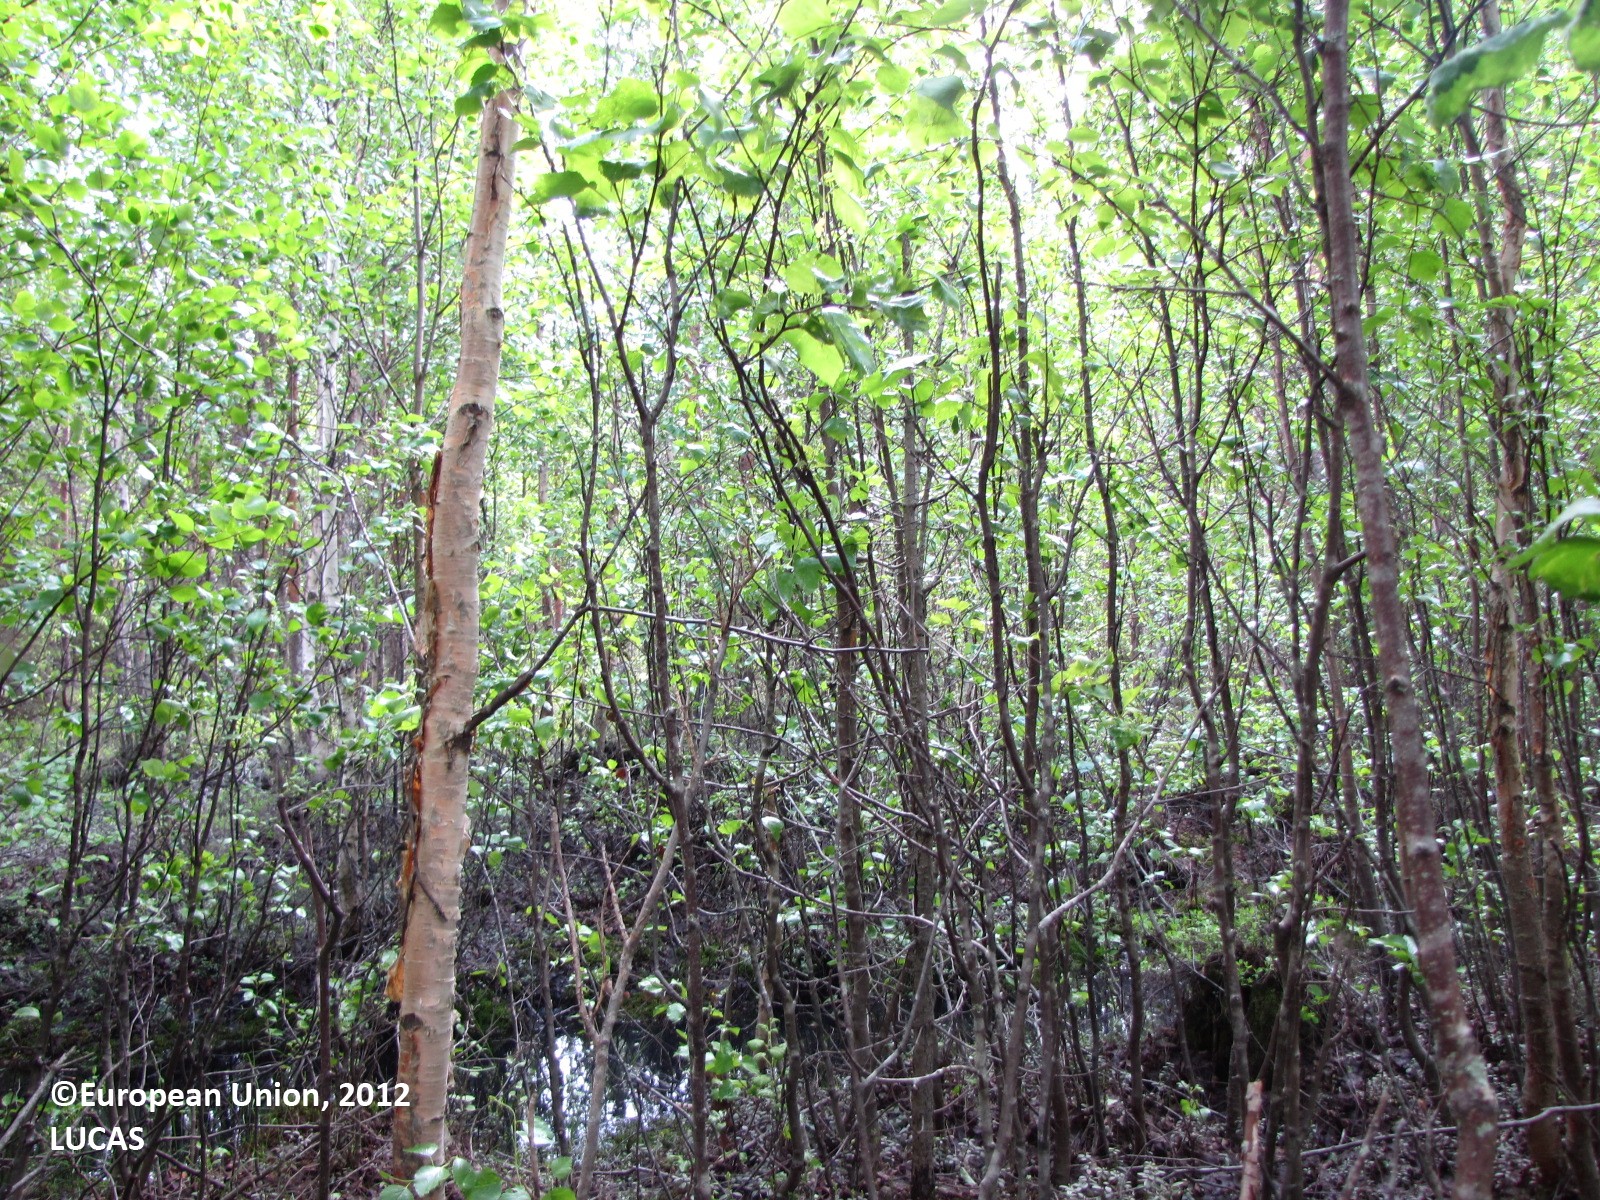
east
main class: Woodland
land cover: Pine dominated mixed woodland
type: boreal forest
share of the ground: 50 - 75 %
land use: Forestry
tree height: > 5 m
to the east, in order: Pine dominated mixed woodland; Ditches and canals; Pine dominated mixed woodland; Ditches and canals; Other mixed woodland; Ditches and canals; Other mixed woodland; Ditches and canals; Other mixed woodland; Ditches and canals; Pine dominated mixed woodland; Ditches and canals; Pine dominated mixed woodland; Ditches and canals; Pine dominated mixed woodland
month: June
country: FI
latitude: 66.4723
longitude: 24.3423
